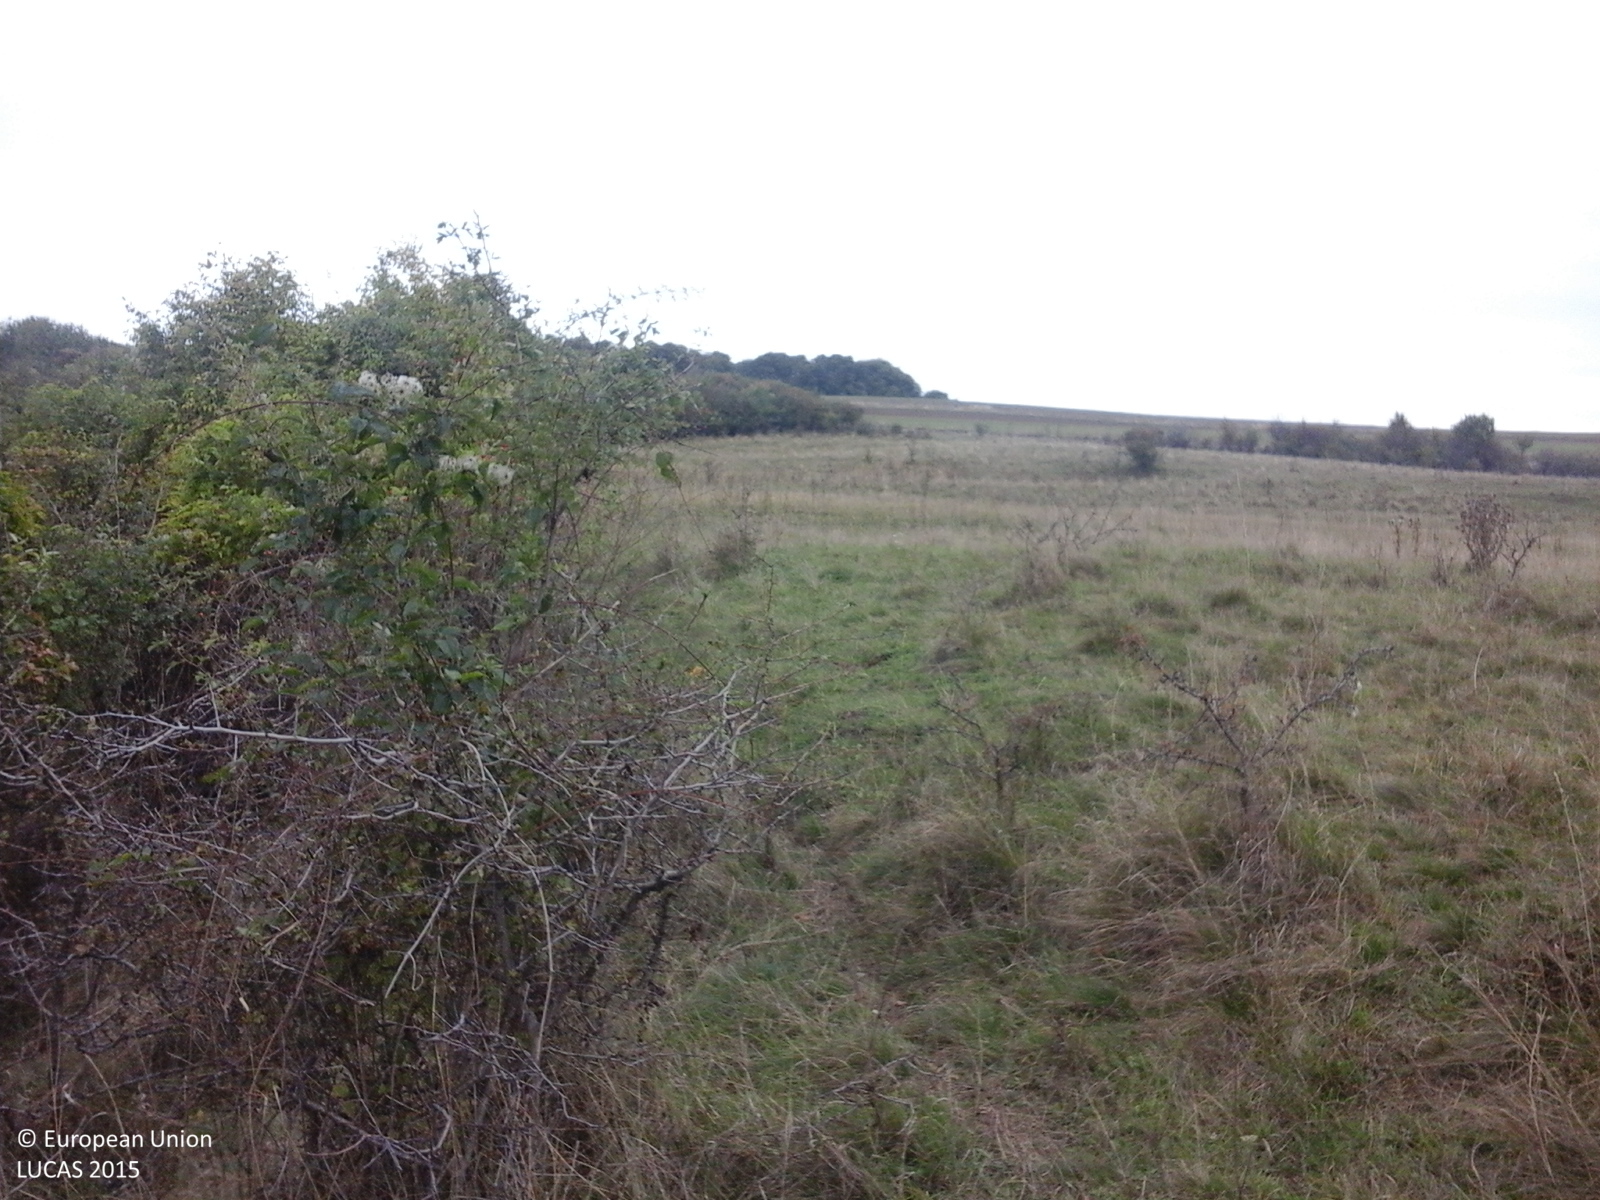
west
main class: Grassland
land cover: Grassland with sparse tree/shrub cover
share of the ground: > 75 %
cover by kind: herbaceous plants 85 %, shrubs 10 %, broadleaved forest trees 5 %
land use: Agriculture (excluding fallow land and kitchen gardens)
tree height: < 5 m
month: October
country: RO
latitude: 46.2343
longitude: 25.1539
